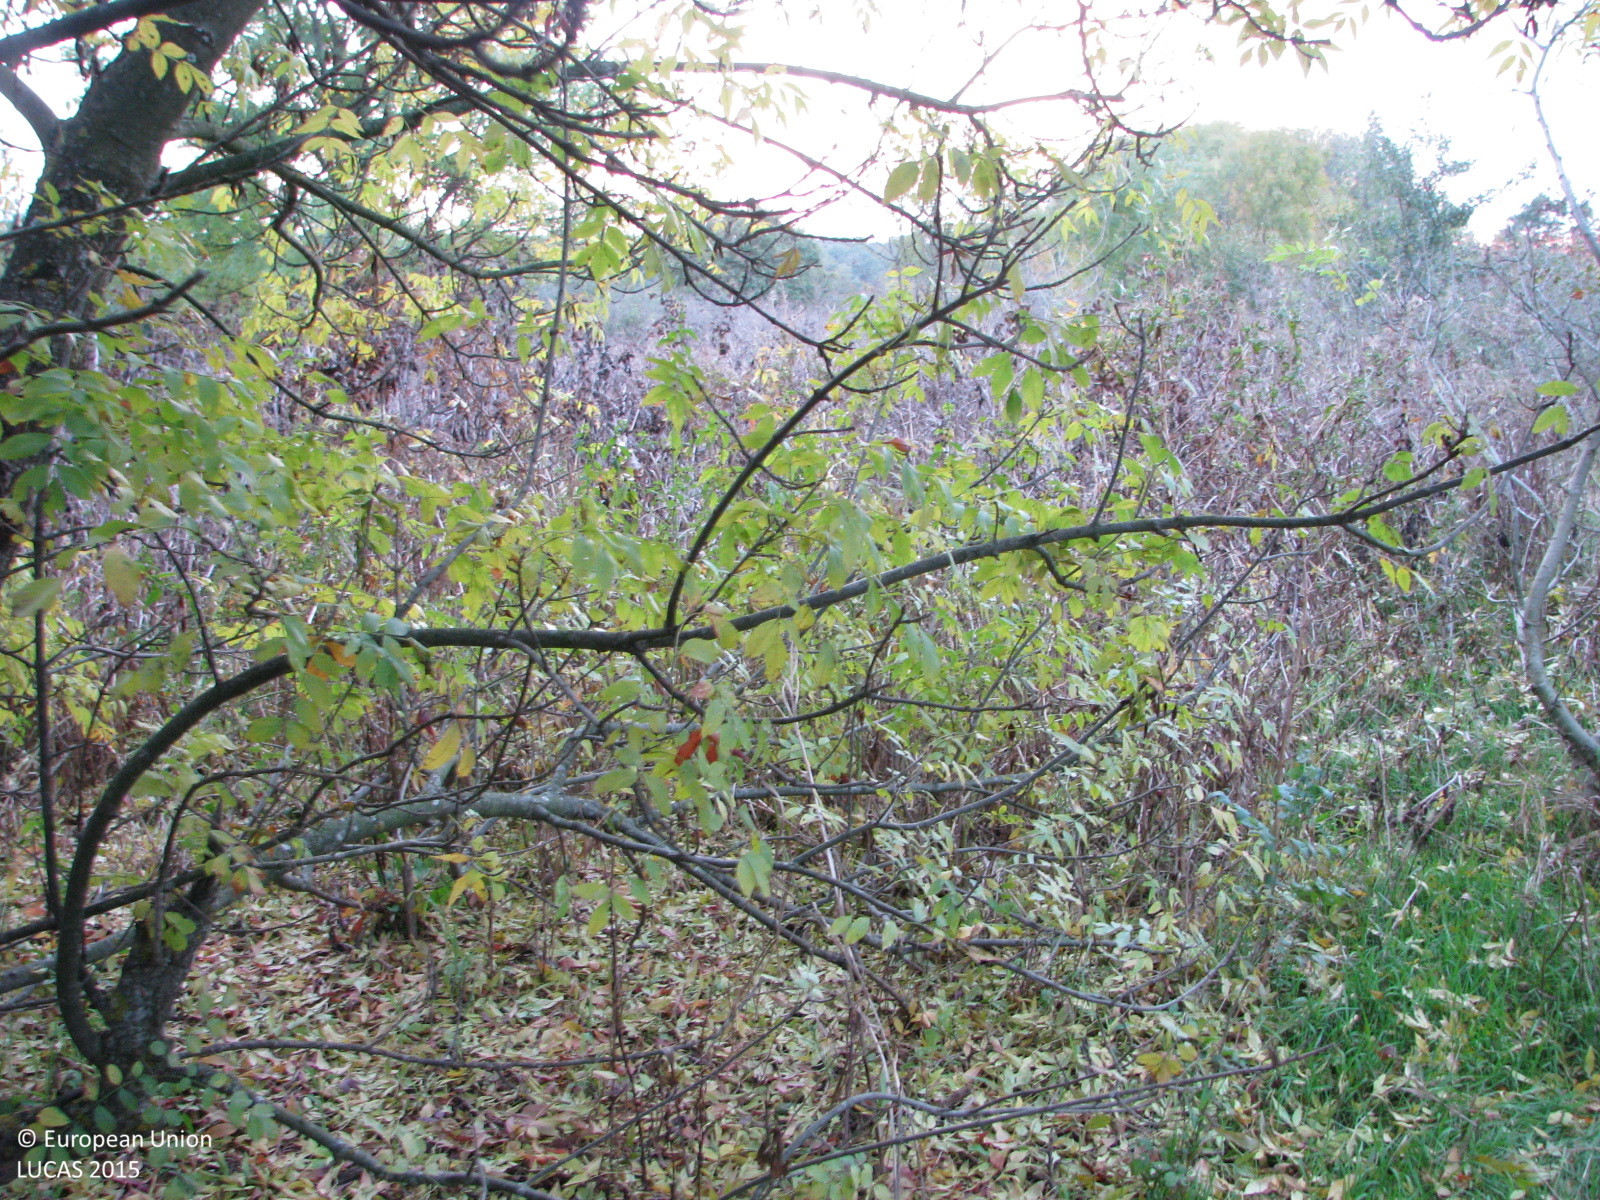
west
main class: Woodland
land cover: Broadleaved woodland
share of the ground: 10 - 25 %
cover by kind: herbaceous plants 65 %, broadleaved forest trees 20 %, shrubs 15 %
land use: Semi-natural and natural areas not in use
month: October
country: BG
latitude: 42.2791
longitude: 26.7442
